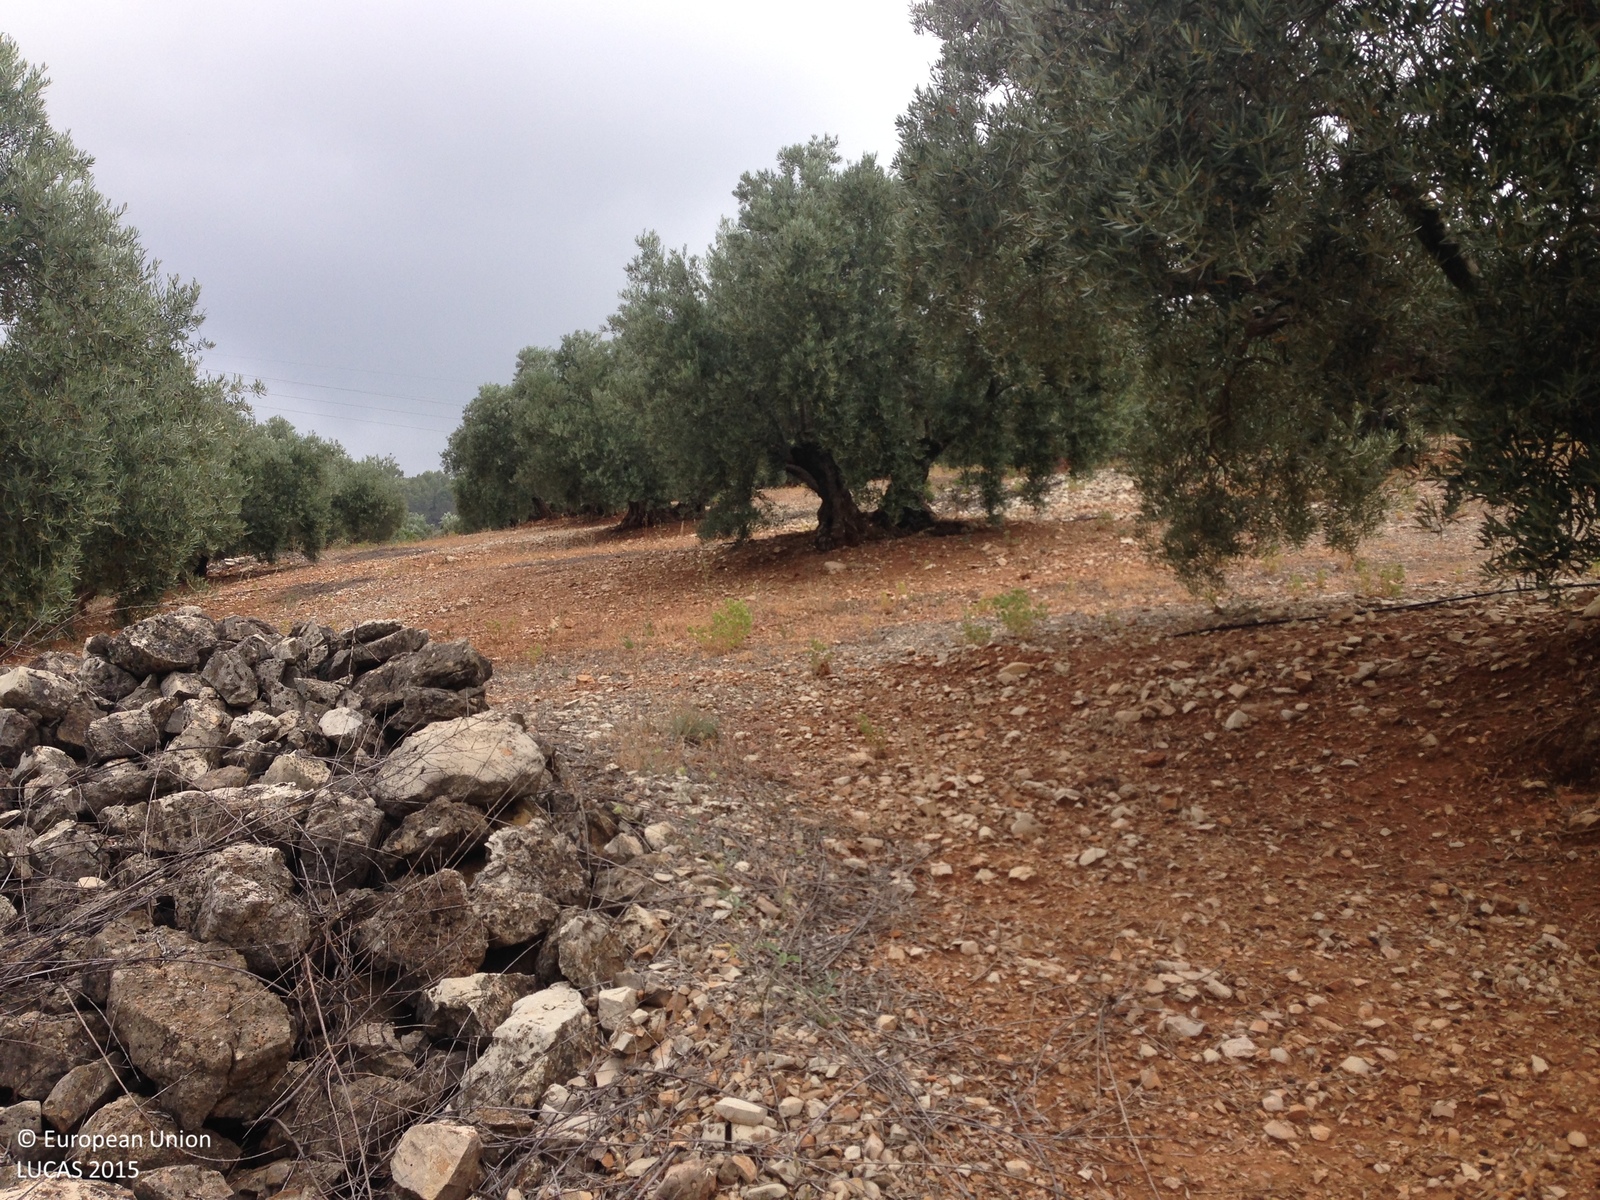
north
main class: Cropland
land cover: Olive groves
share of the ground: 25 - 50 %
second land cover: Other bare soil
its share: > 75 %
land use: Agriculture (excluding fallow land and kitchen gardens)
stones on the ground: > 50 %
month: June
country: ES
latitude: 38.1805
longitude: -2.9327
